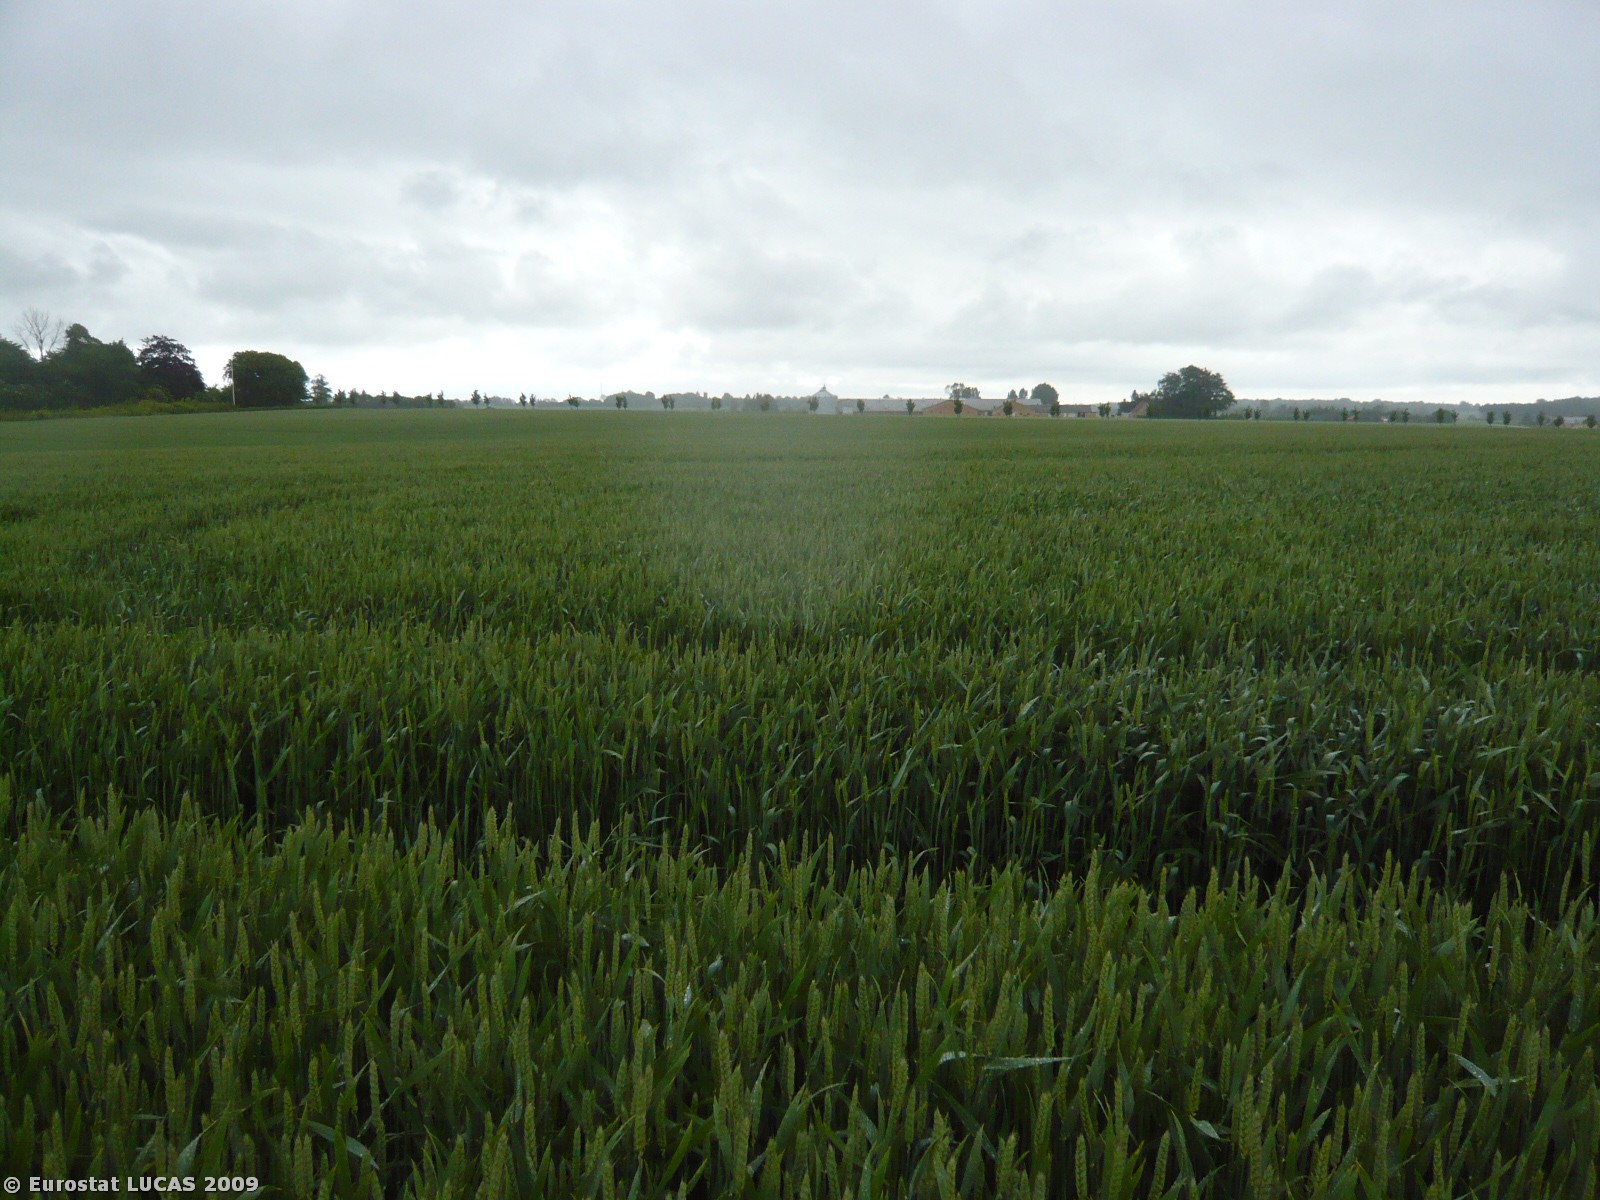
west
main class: Cropland
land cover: Common wheat
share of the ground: > 75 %
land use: Agriculture (excluding fallow land and kitchen gardens)
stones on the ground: 10 - 25 %
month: June
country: DK
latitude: 54.7882
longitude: 11.9738
